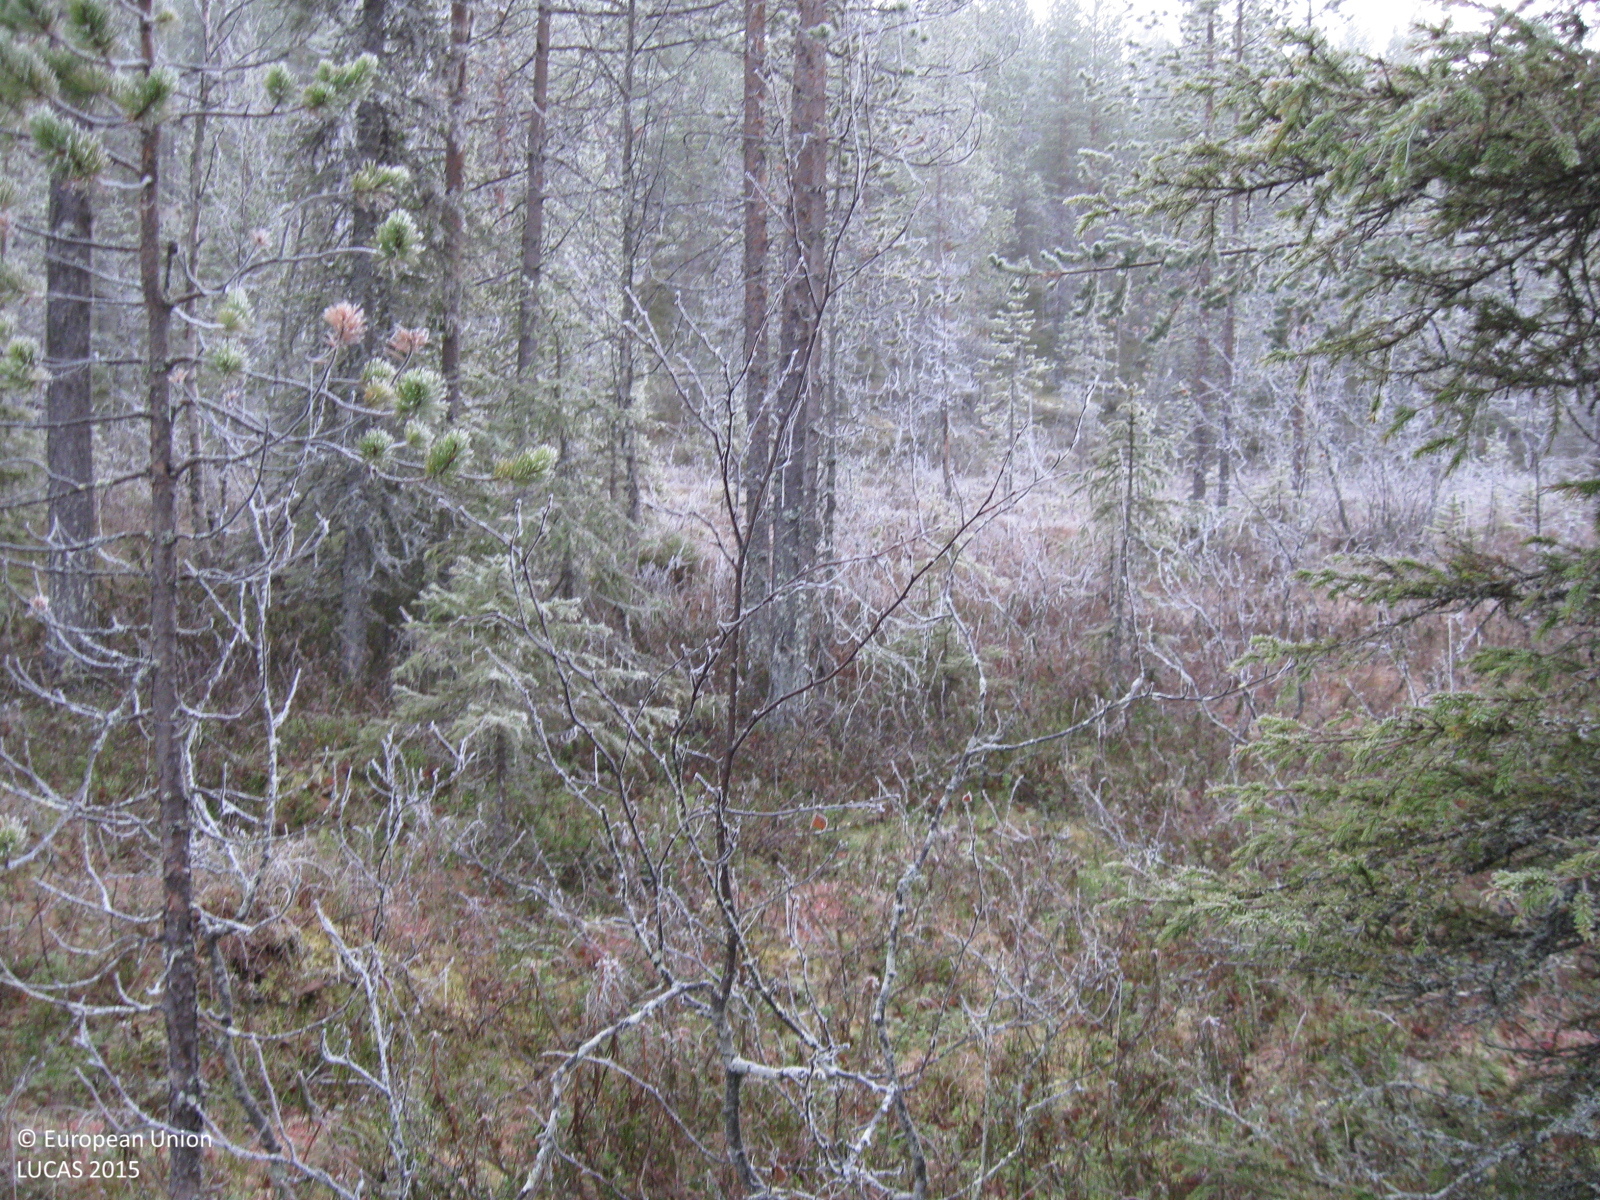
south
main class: Woodland
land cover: Pine dominated coniferous woodland
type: boreal forest
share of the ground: > 75 %
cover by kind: coniferous forest trees 60 %, broadleaved forest trees 15 %, shrubs 10 %, lichens and mosses 10 %, herbaceous plants 5 %
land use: Forestry
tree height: > 5 m
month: October
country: SE
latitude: 66.4168
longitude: 21.7250
